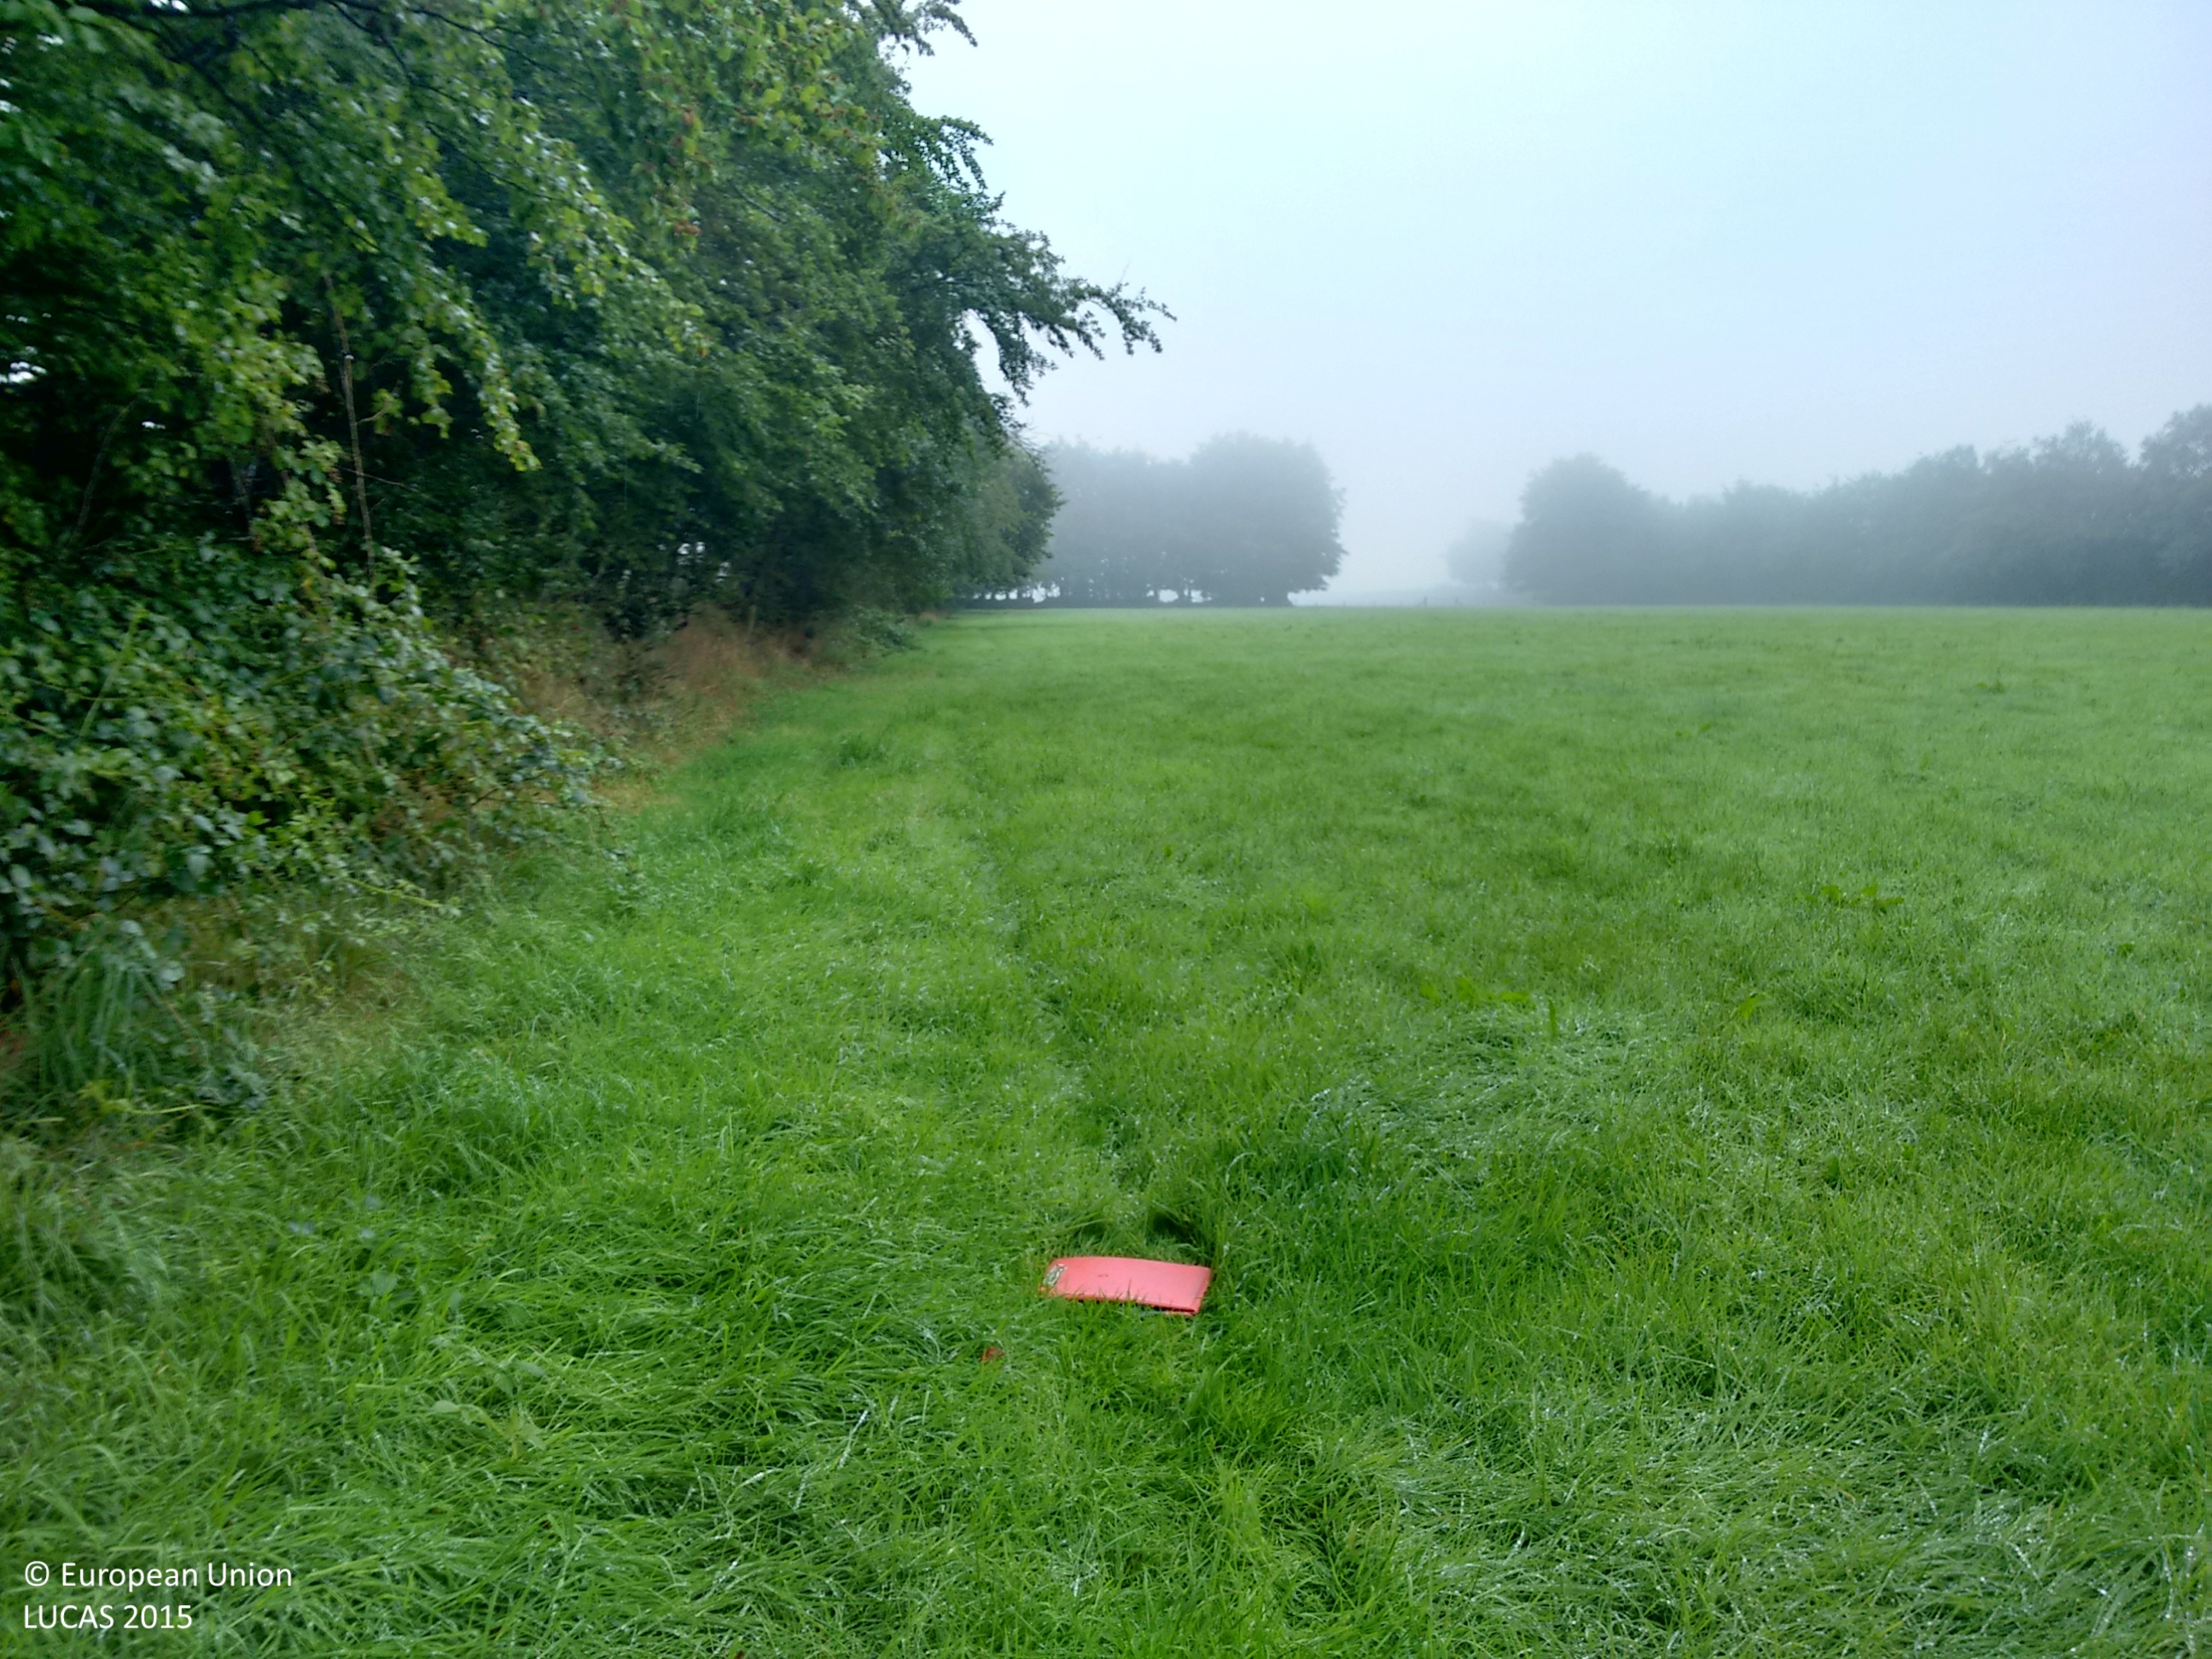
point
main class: Cropland
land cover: Temporary grasslands
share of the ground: > 75 %
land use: Agriculture (excluding fallow land and kitchen gardens)
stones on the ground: < 10 %
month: August
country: GB
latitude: 50.9451
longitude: -3.1867
